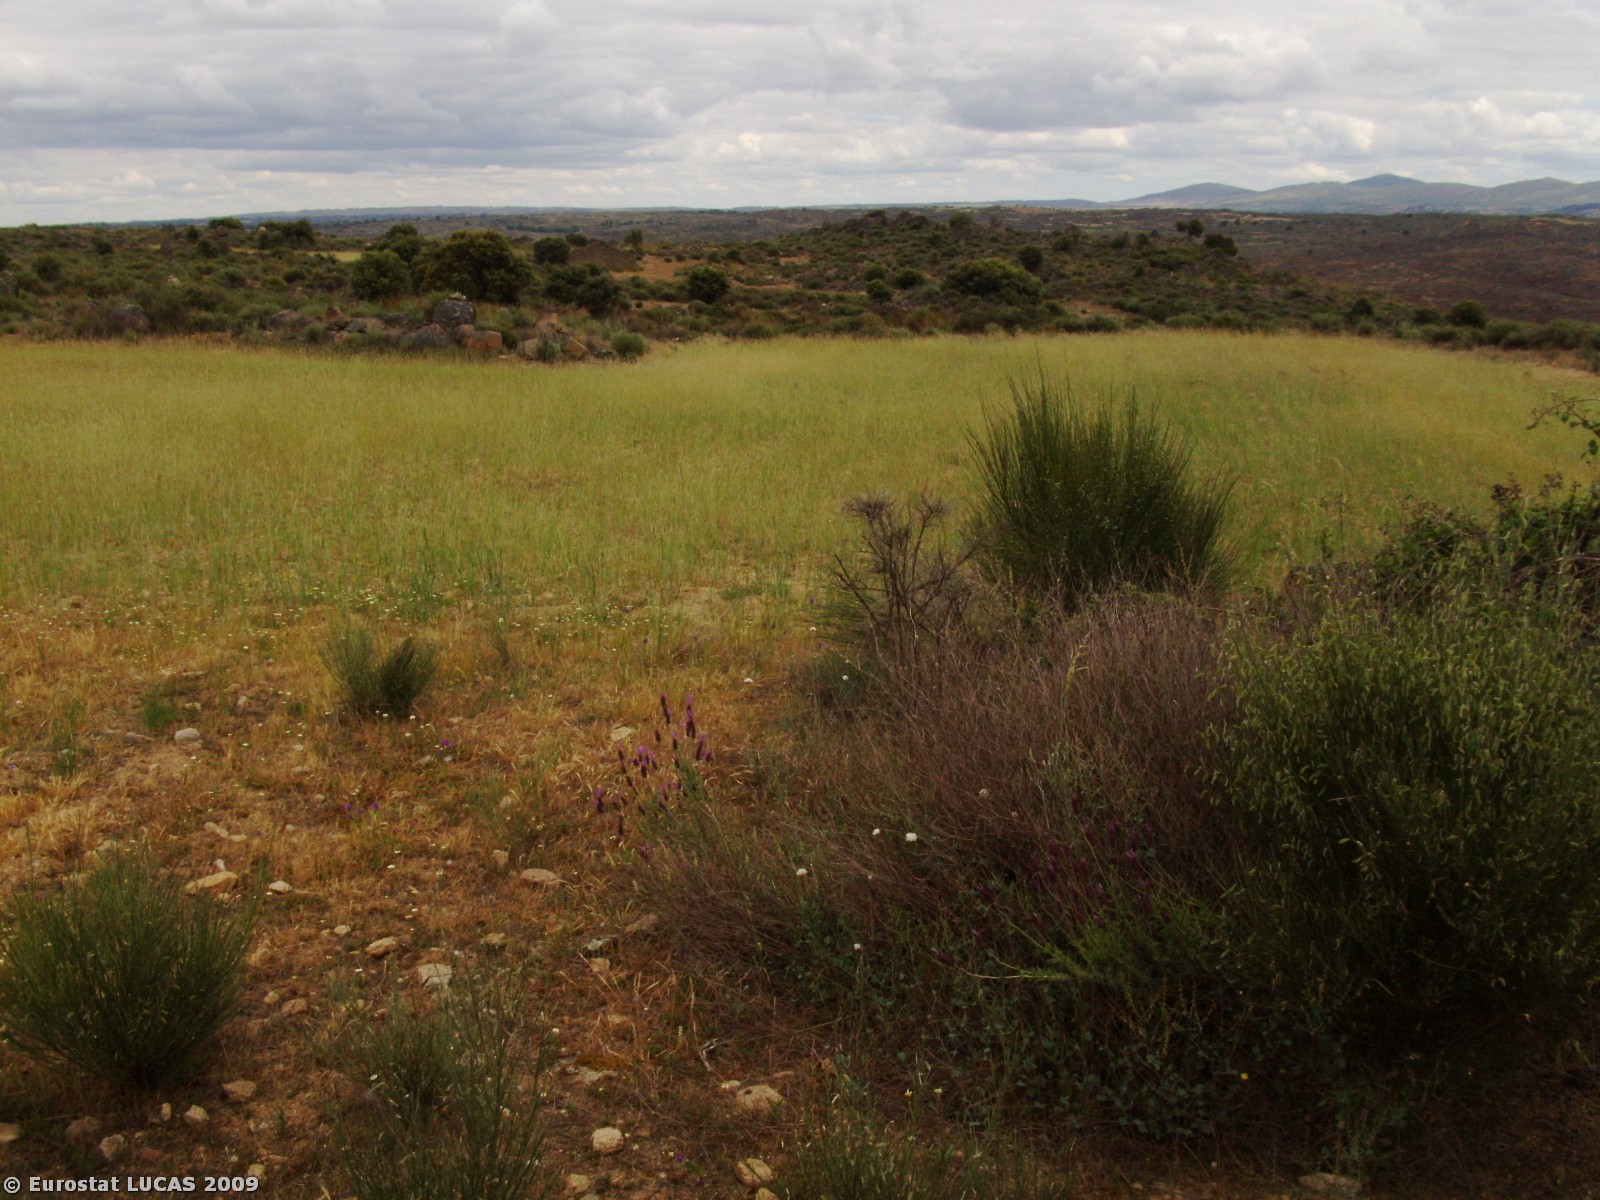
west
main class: Shrubland
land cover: Shrubland without tree cover
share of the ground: 25 - 50 %
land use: Nature reserves
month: May
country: PT
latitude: 40.8989
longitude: -7.1670
